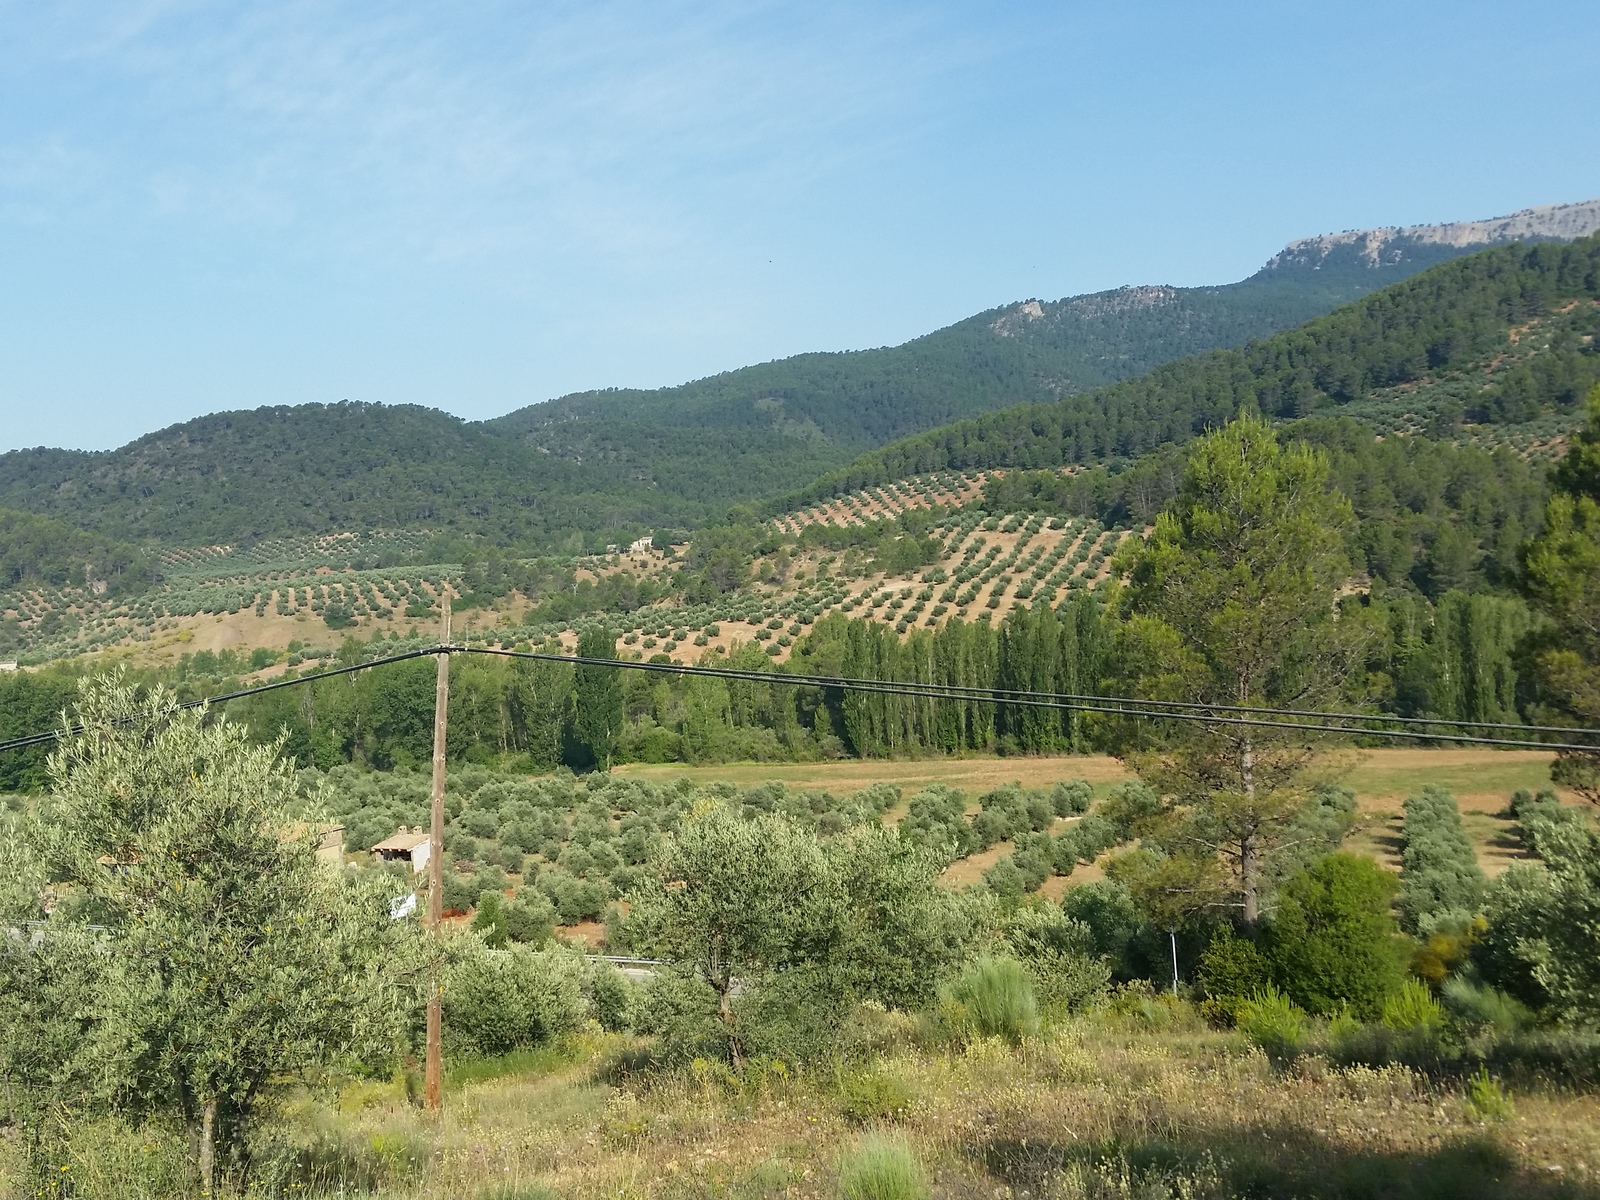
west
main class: Cropland
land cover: Olive groves
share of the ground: 25 - 50 %
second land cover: Grassland without tree/shrub cover
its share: 10 - 25 %
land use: Agriculture (excluding fallow land and kitchen gardens)
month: June
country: ES
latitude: 38.4372
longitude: -2.5202
